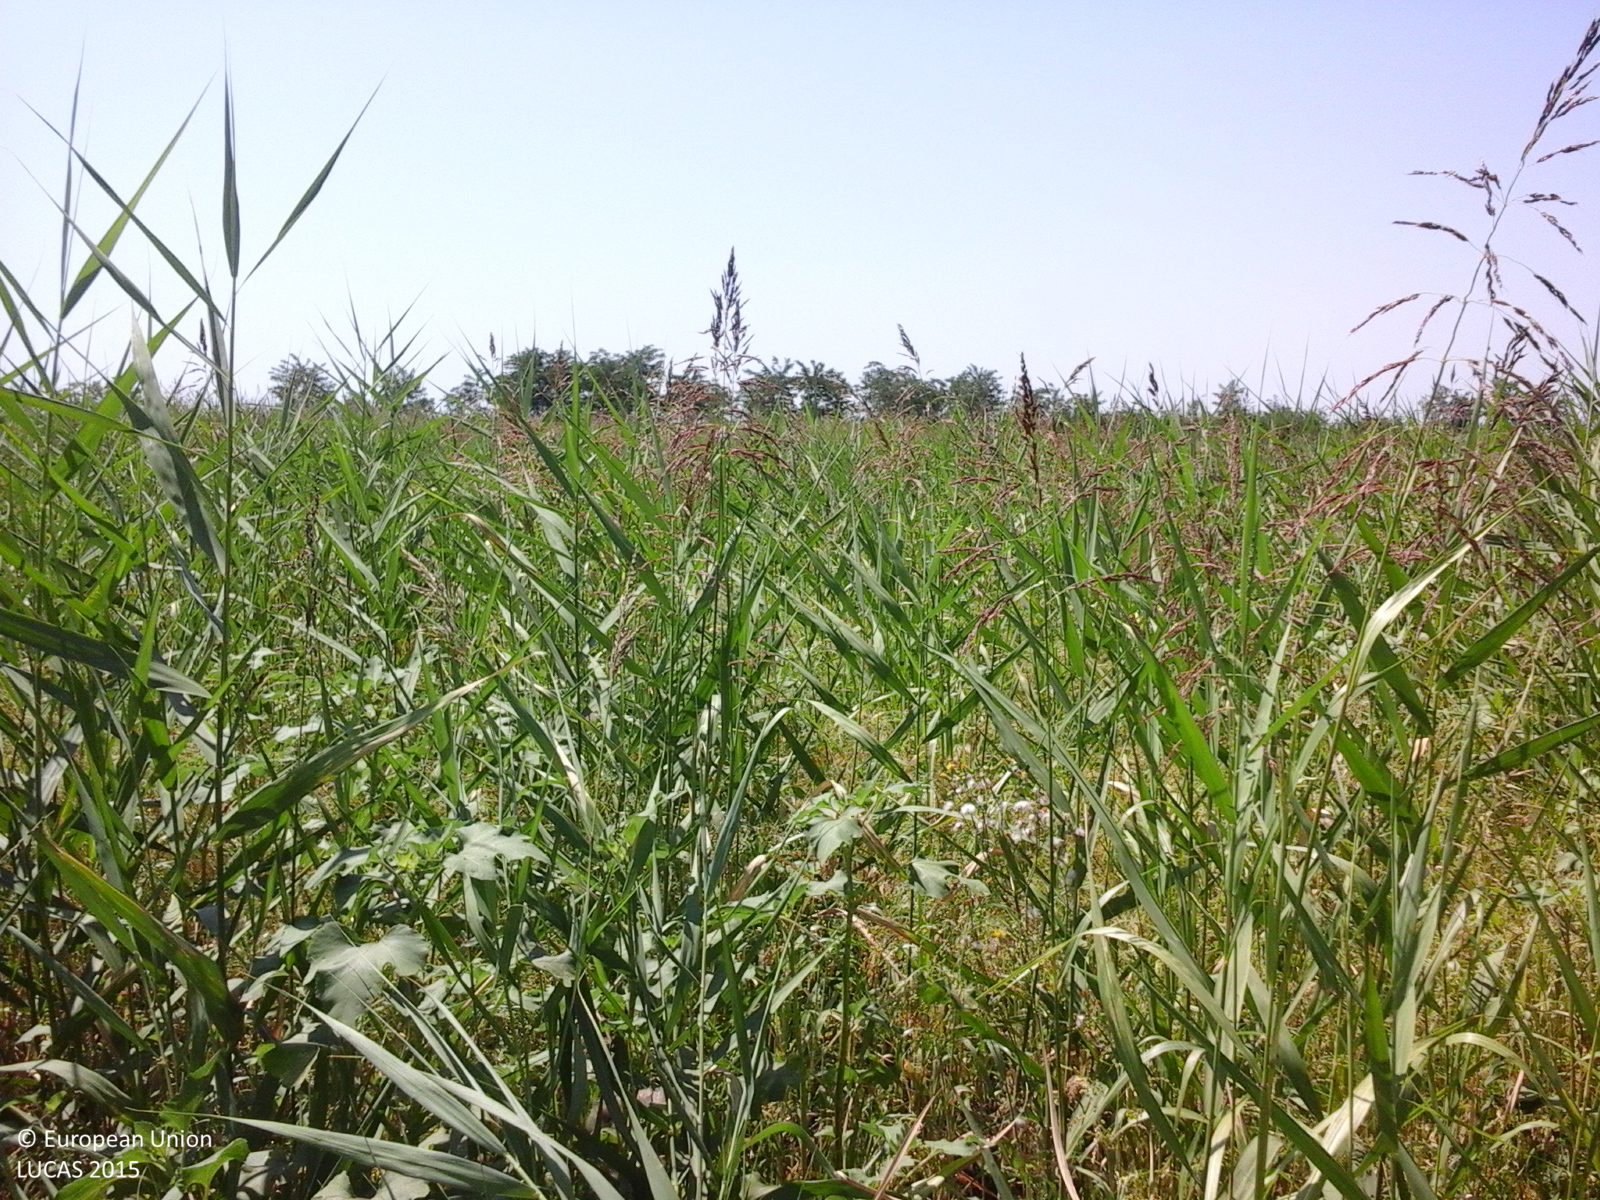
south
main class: Grassland
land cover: Spontaneously vegetated surfaces
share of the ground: > 75 %
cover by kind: herbaceous plants 100 %
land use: Fallow land
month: July
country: RO
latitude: 45.0383
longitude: 27.1883
